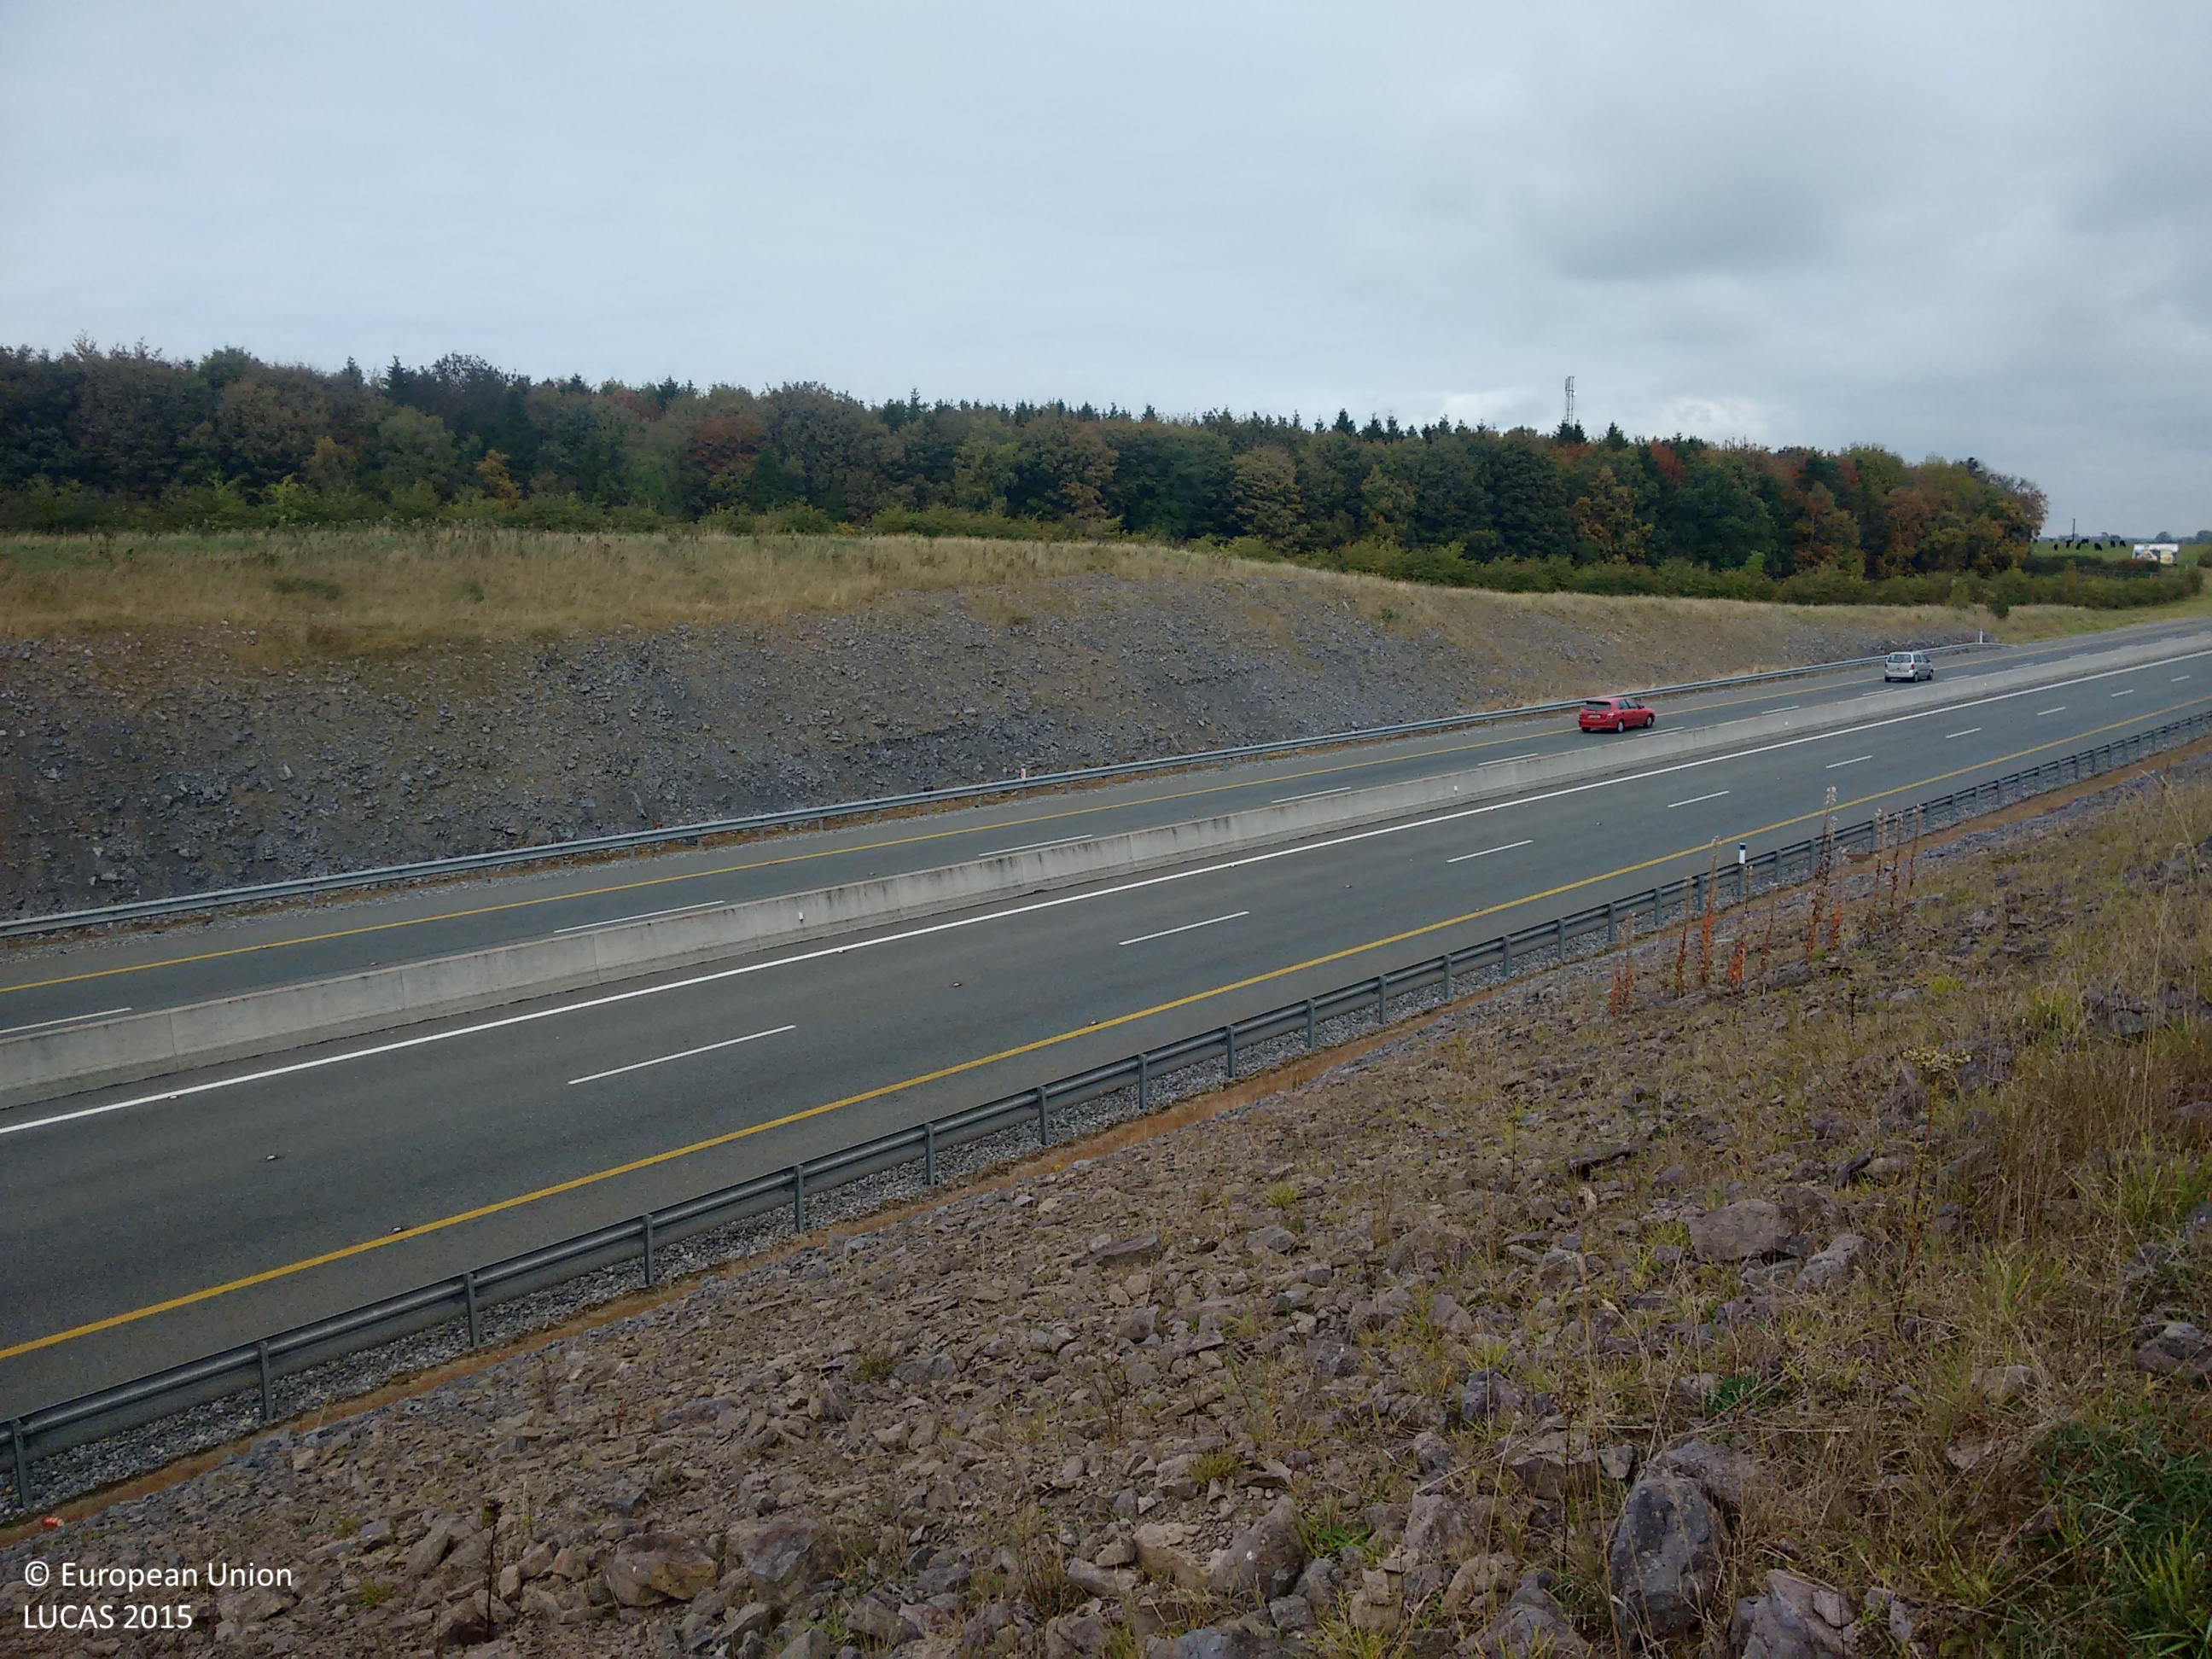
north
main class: Woodland
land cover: Broadleaved woodland
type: mesophytic deciduous forest
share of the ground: > 75 %
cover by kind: broadleaved forest trees 65 %, herbaceous plants 35 %
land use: Forestry
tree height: > 5 m
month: October
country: IE
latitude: 52.8515
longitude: -7.4879
